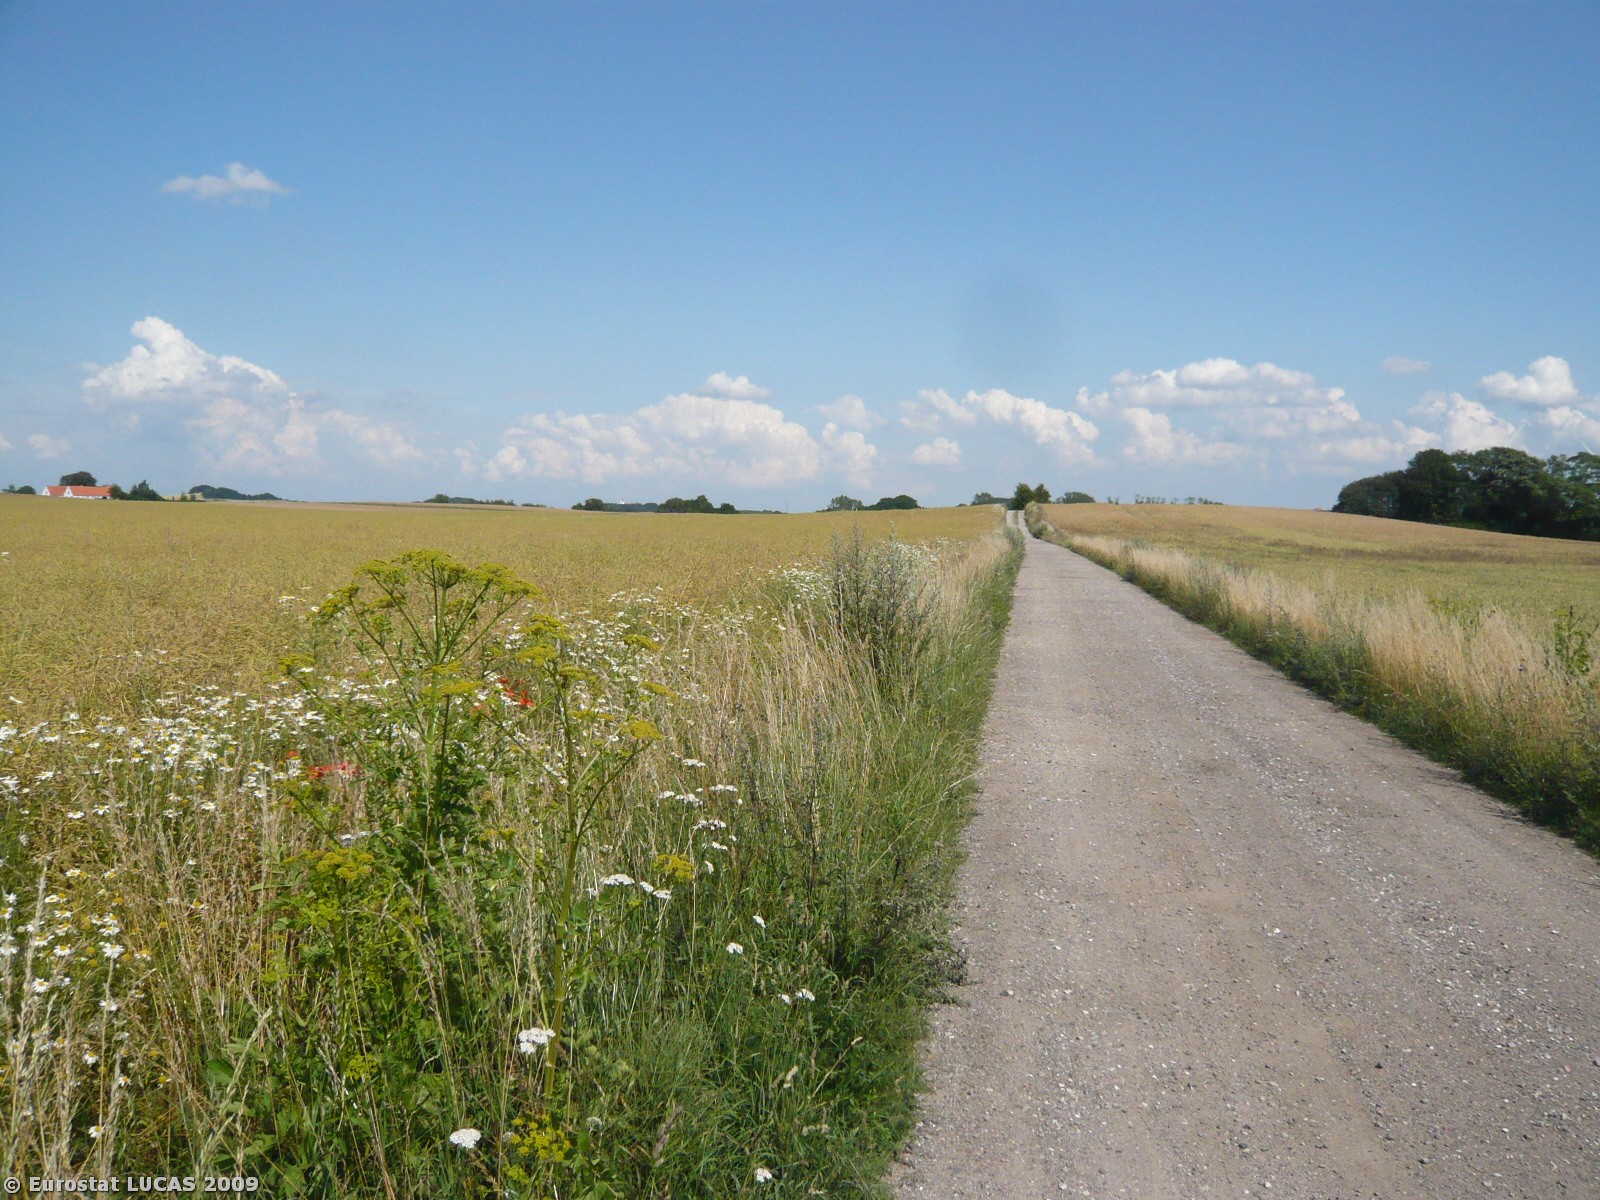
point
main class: Cropland
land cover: Rape and turnip rape
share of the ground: > 75 %
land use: Agriculture (excluding fallow land and kitchen gardens)
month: July
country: DK
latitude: 55.6938
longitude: 11.4781
